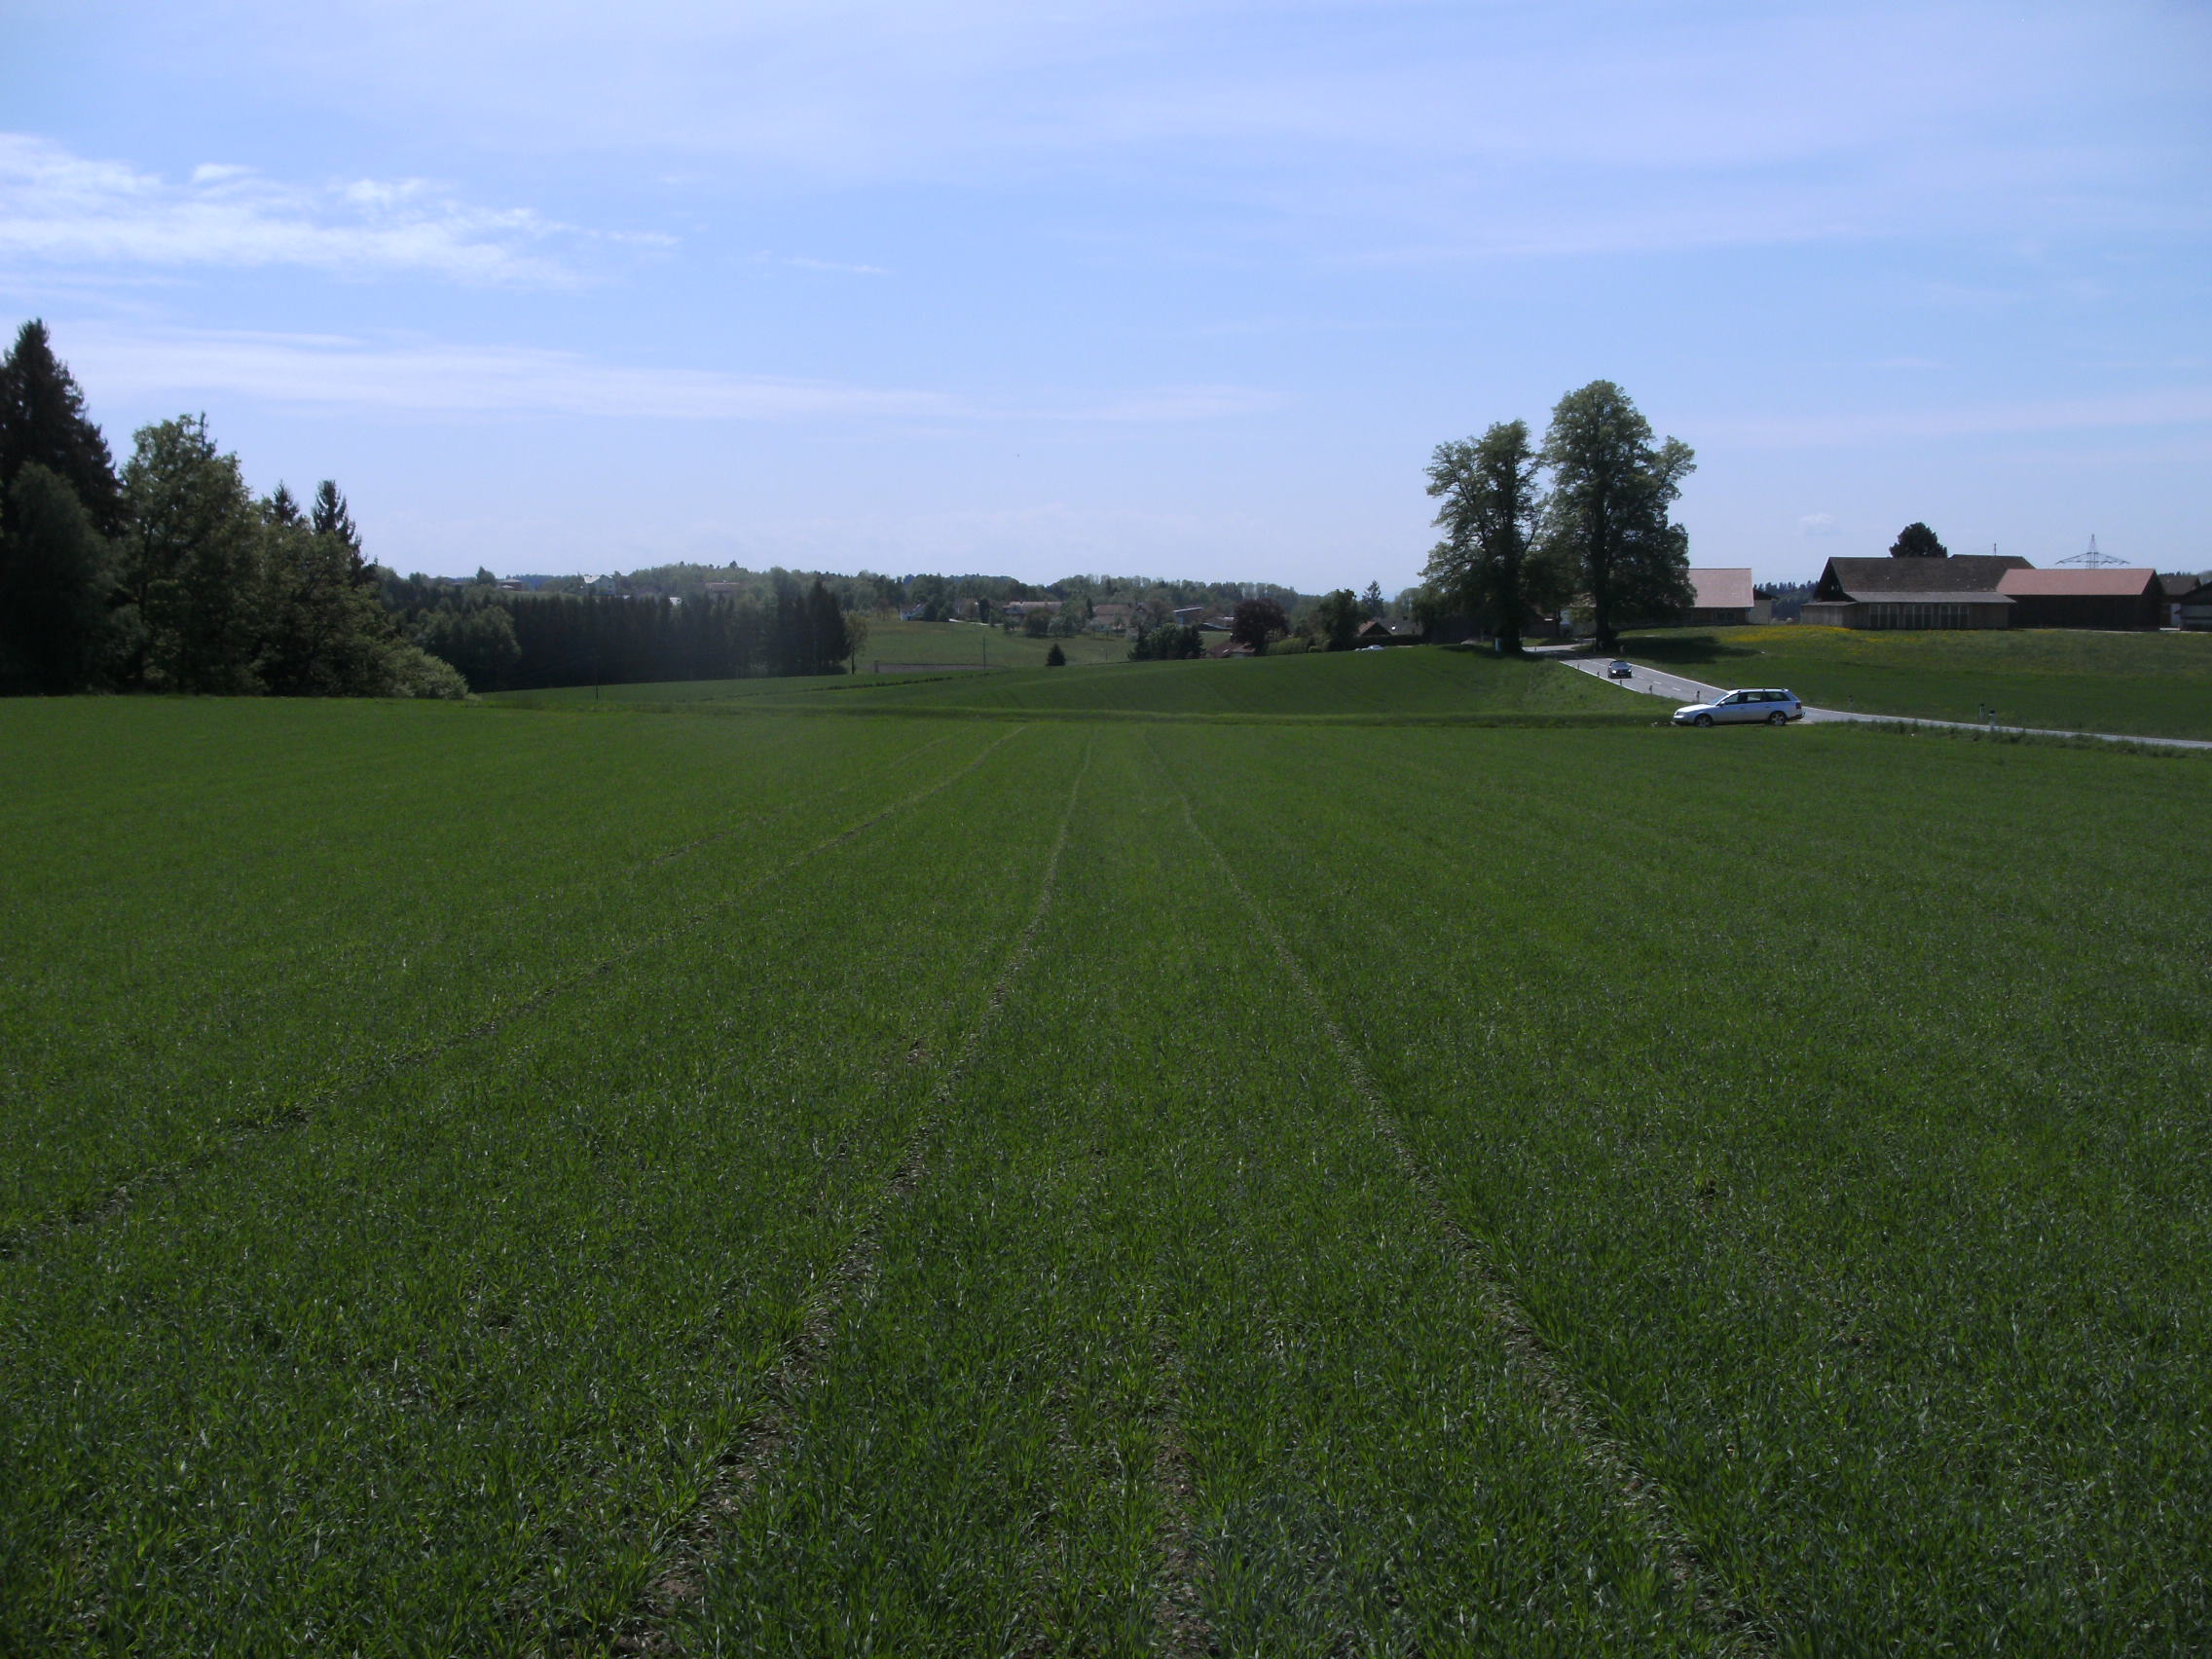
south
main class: Cropland
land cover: Barley
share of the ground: > 75 %
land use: Agriculture (excluding fallow land and kitchen gardens)
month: May
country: AT
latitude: 48.5109
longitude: 13.4785
